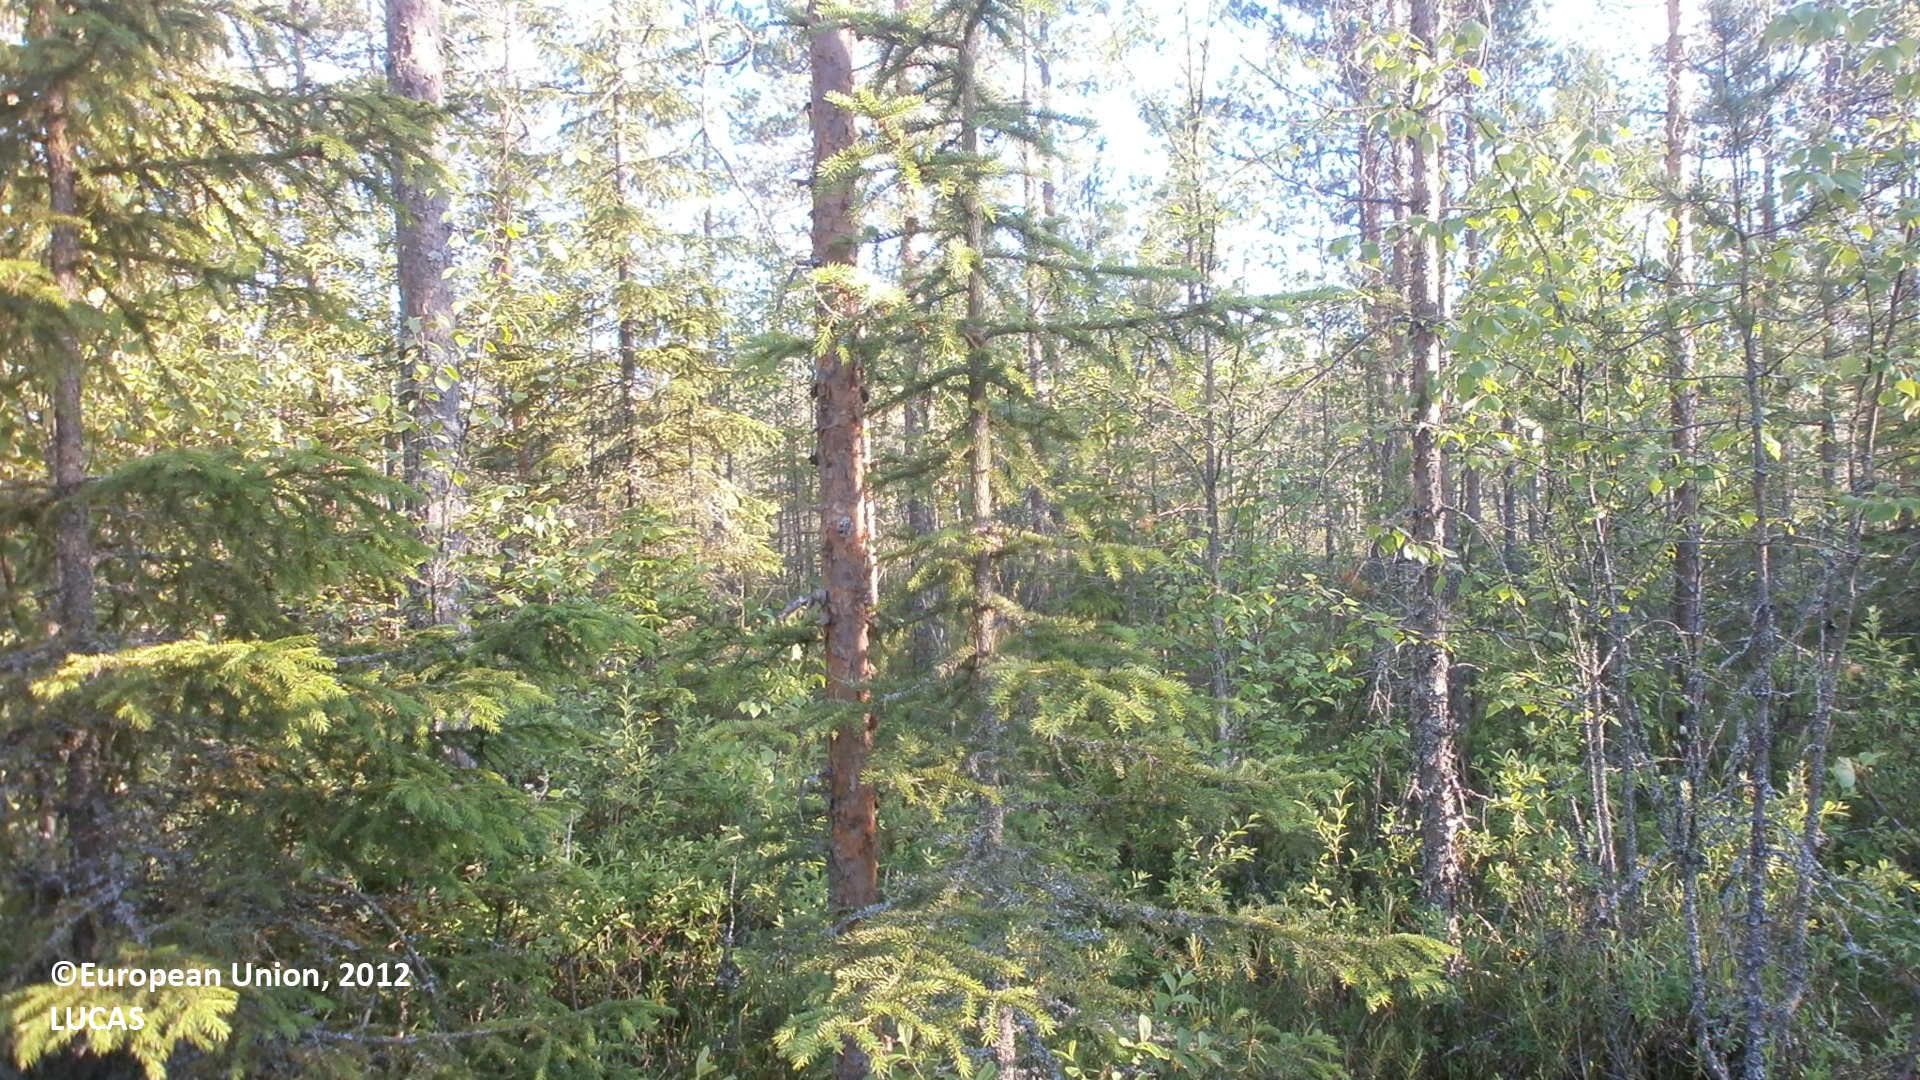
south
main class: Woodland
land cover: Pine dominated coniferous woodland
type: boreal forest
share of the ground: 50 - 75 %
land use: Forestry
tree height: > 5 m
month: July
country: FI
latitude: 64.2380
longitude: 24.9490
